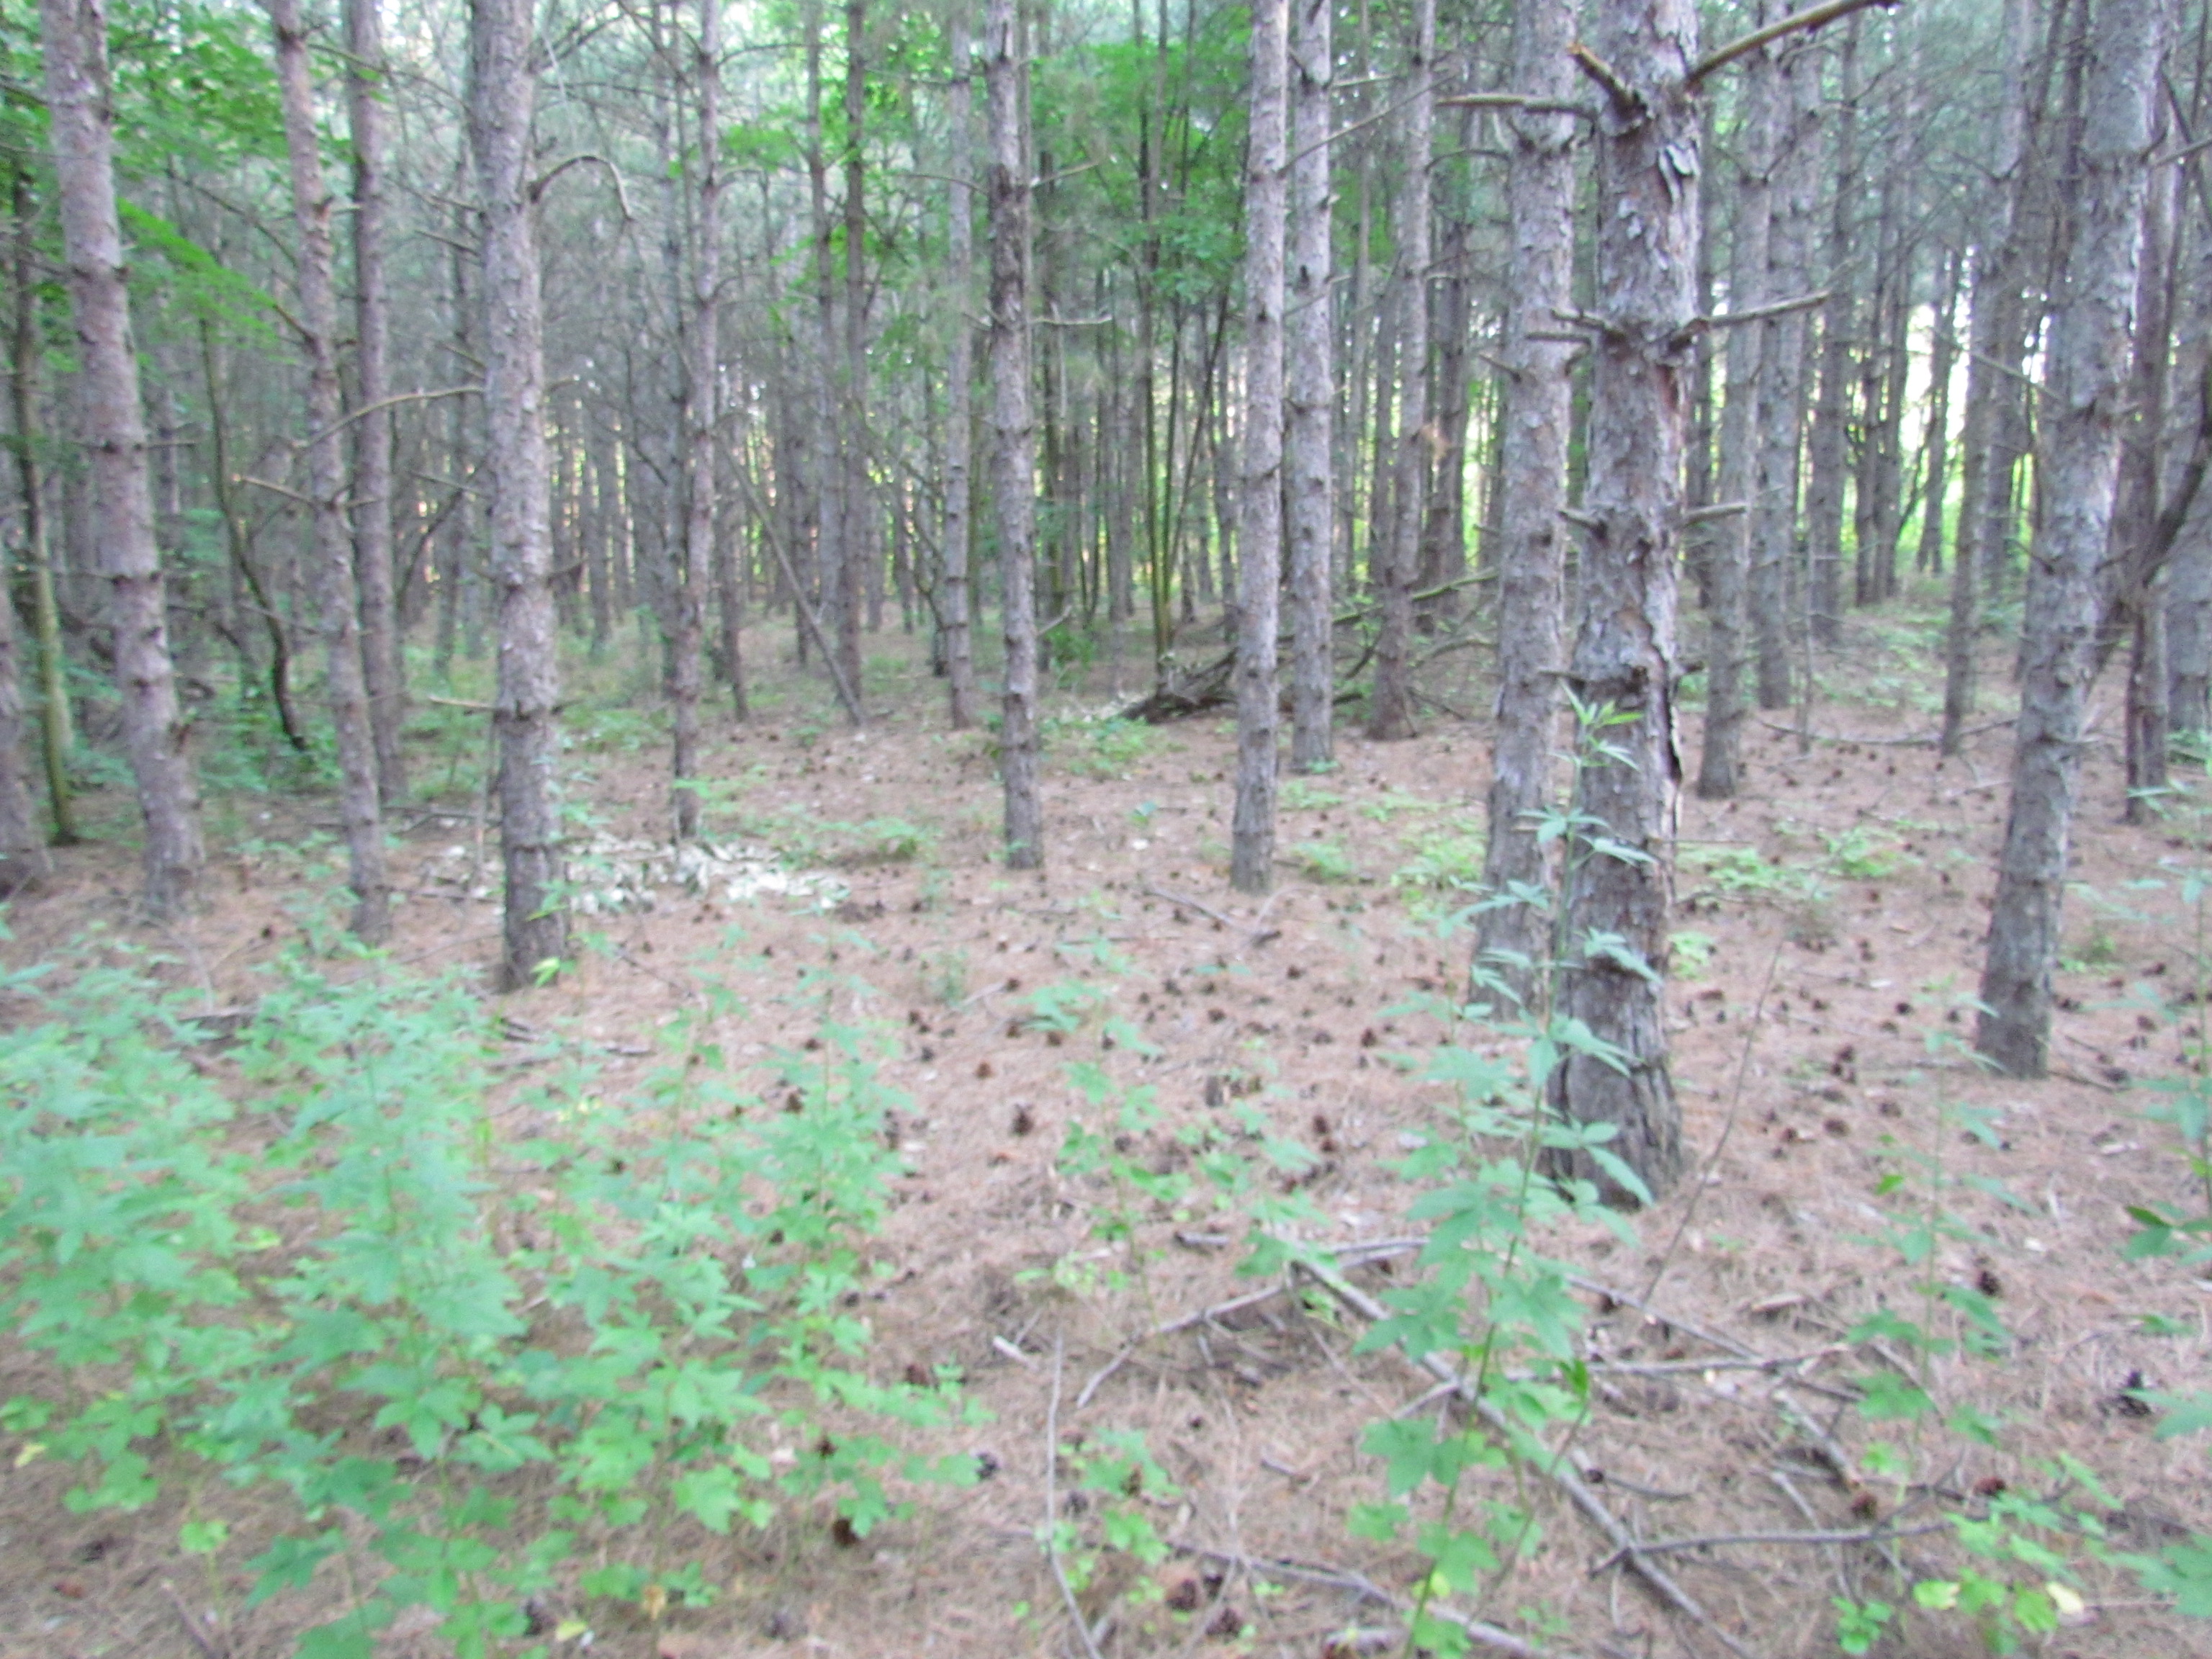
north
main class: Woodland
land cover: Pine dominated coniferous woodland
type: hemiboreal forest and nemoral coniferous forest and mixed broadleaved-coniferous forest
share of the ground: > 75 %
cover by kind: coniferous forest trees 100 %
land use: Forestry
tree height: > 5 m
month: June
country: BG
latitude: 42.6229
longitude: 27.3181
